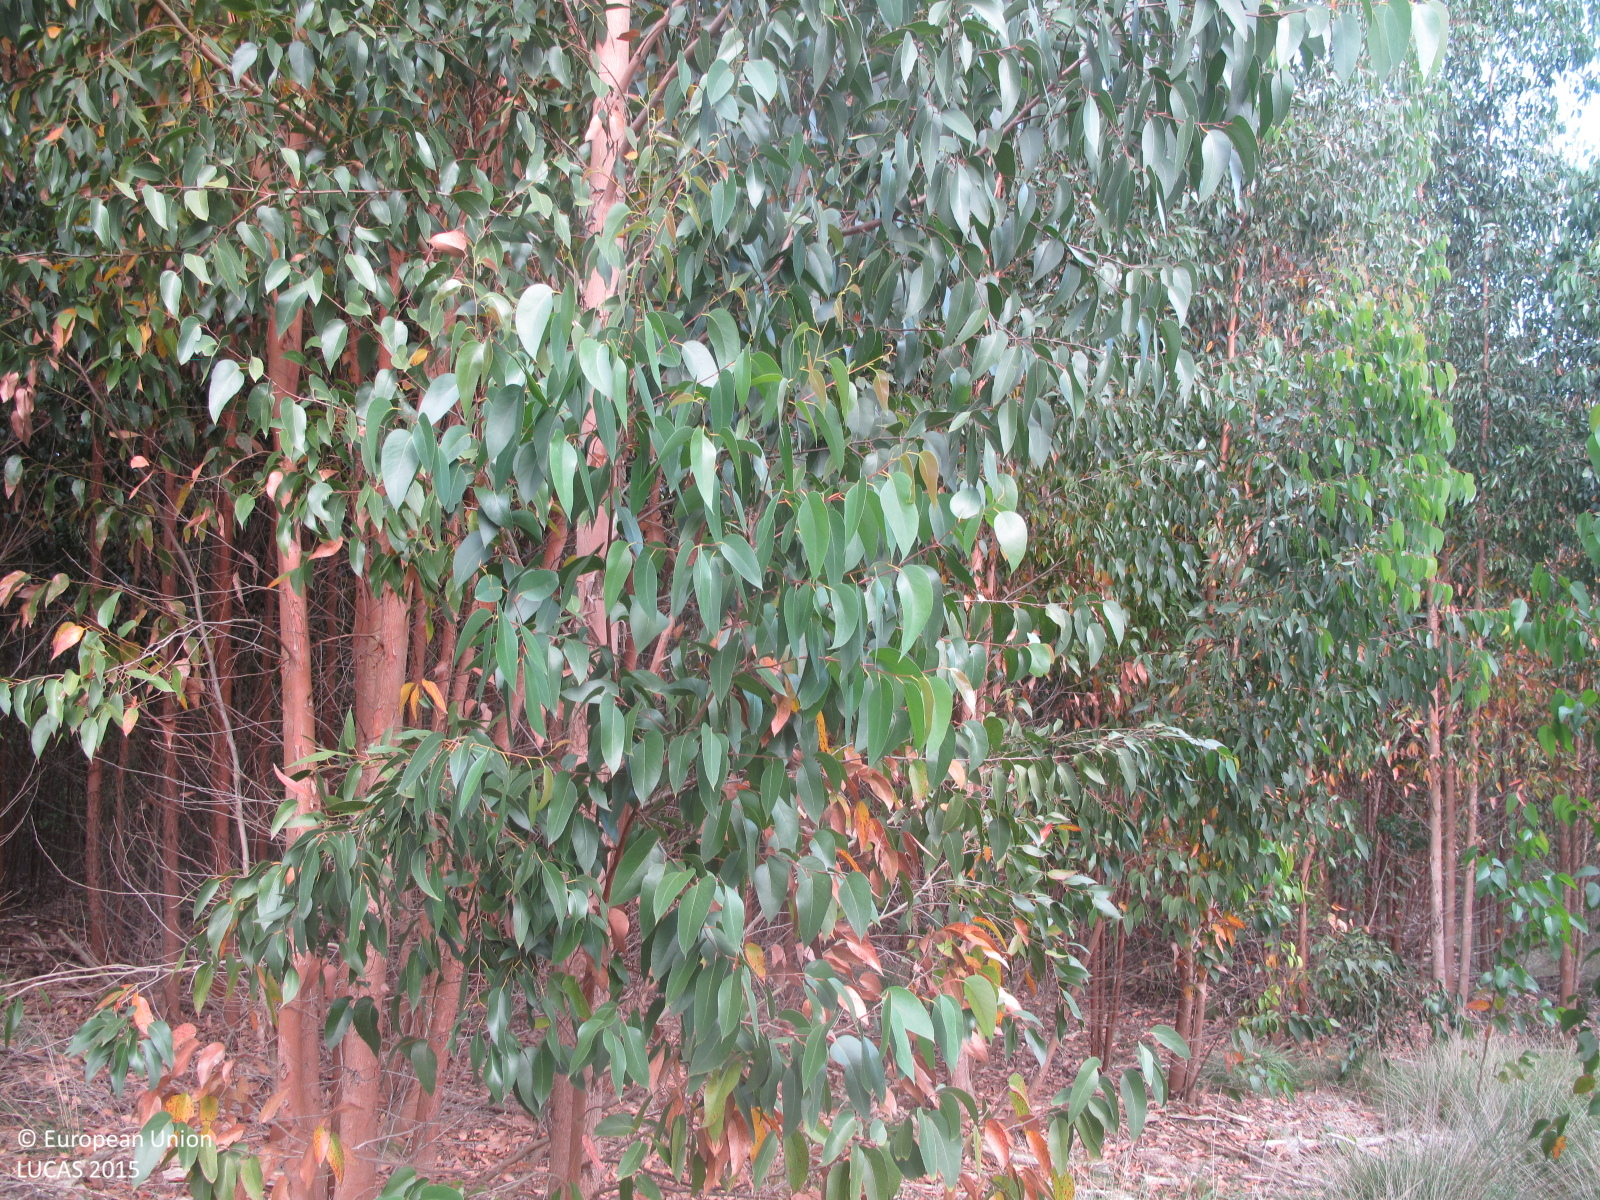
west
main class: Woodland
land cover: Broadleaved woodland
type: exotic forest
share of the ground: 50 - 75 %
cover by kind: broadleaved forest trees 60 %, unconsolidated bare surface 20 %, shrubs 10 %, herbaceous plants 10 %
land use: Forestry
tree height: > 5 m
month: July
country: ES
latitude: 43.2951
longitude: -8.1048
